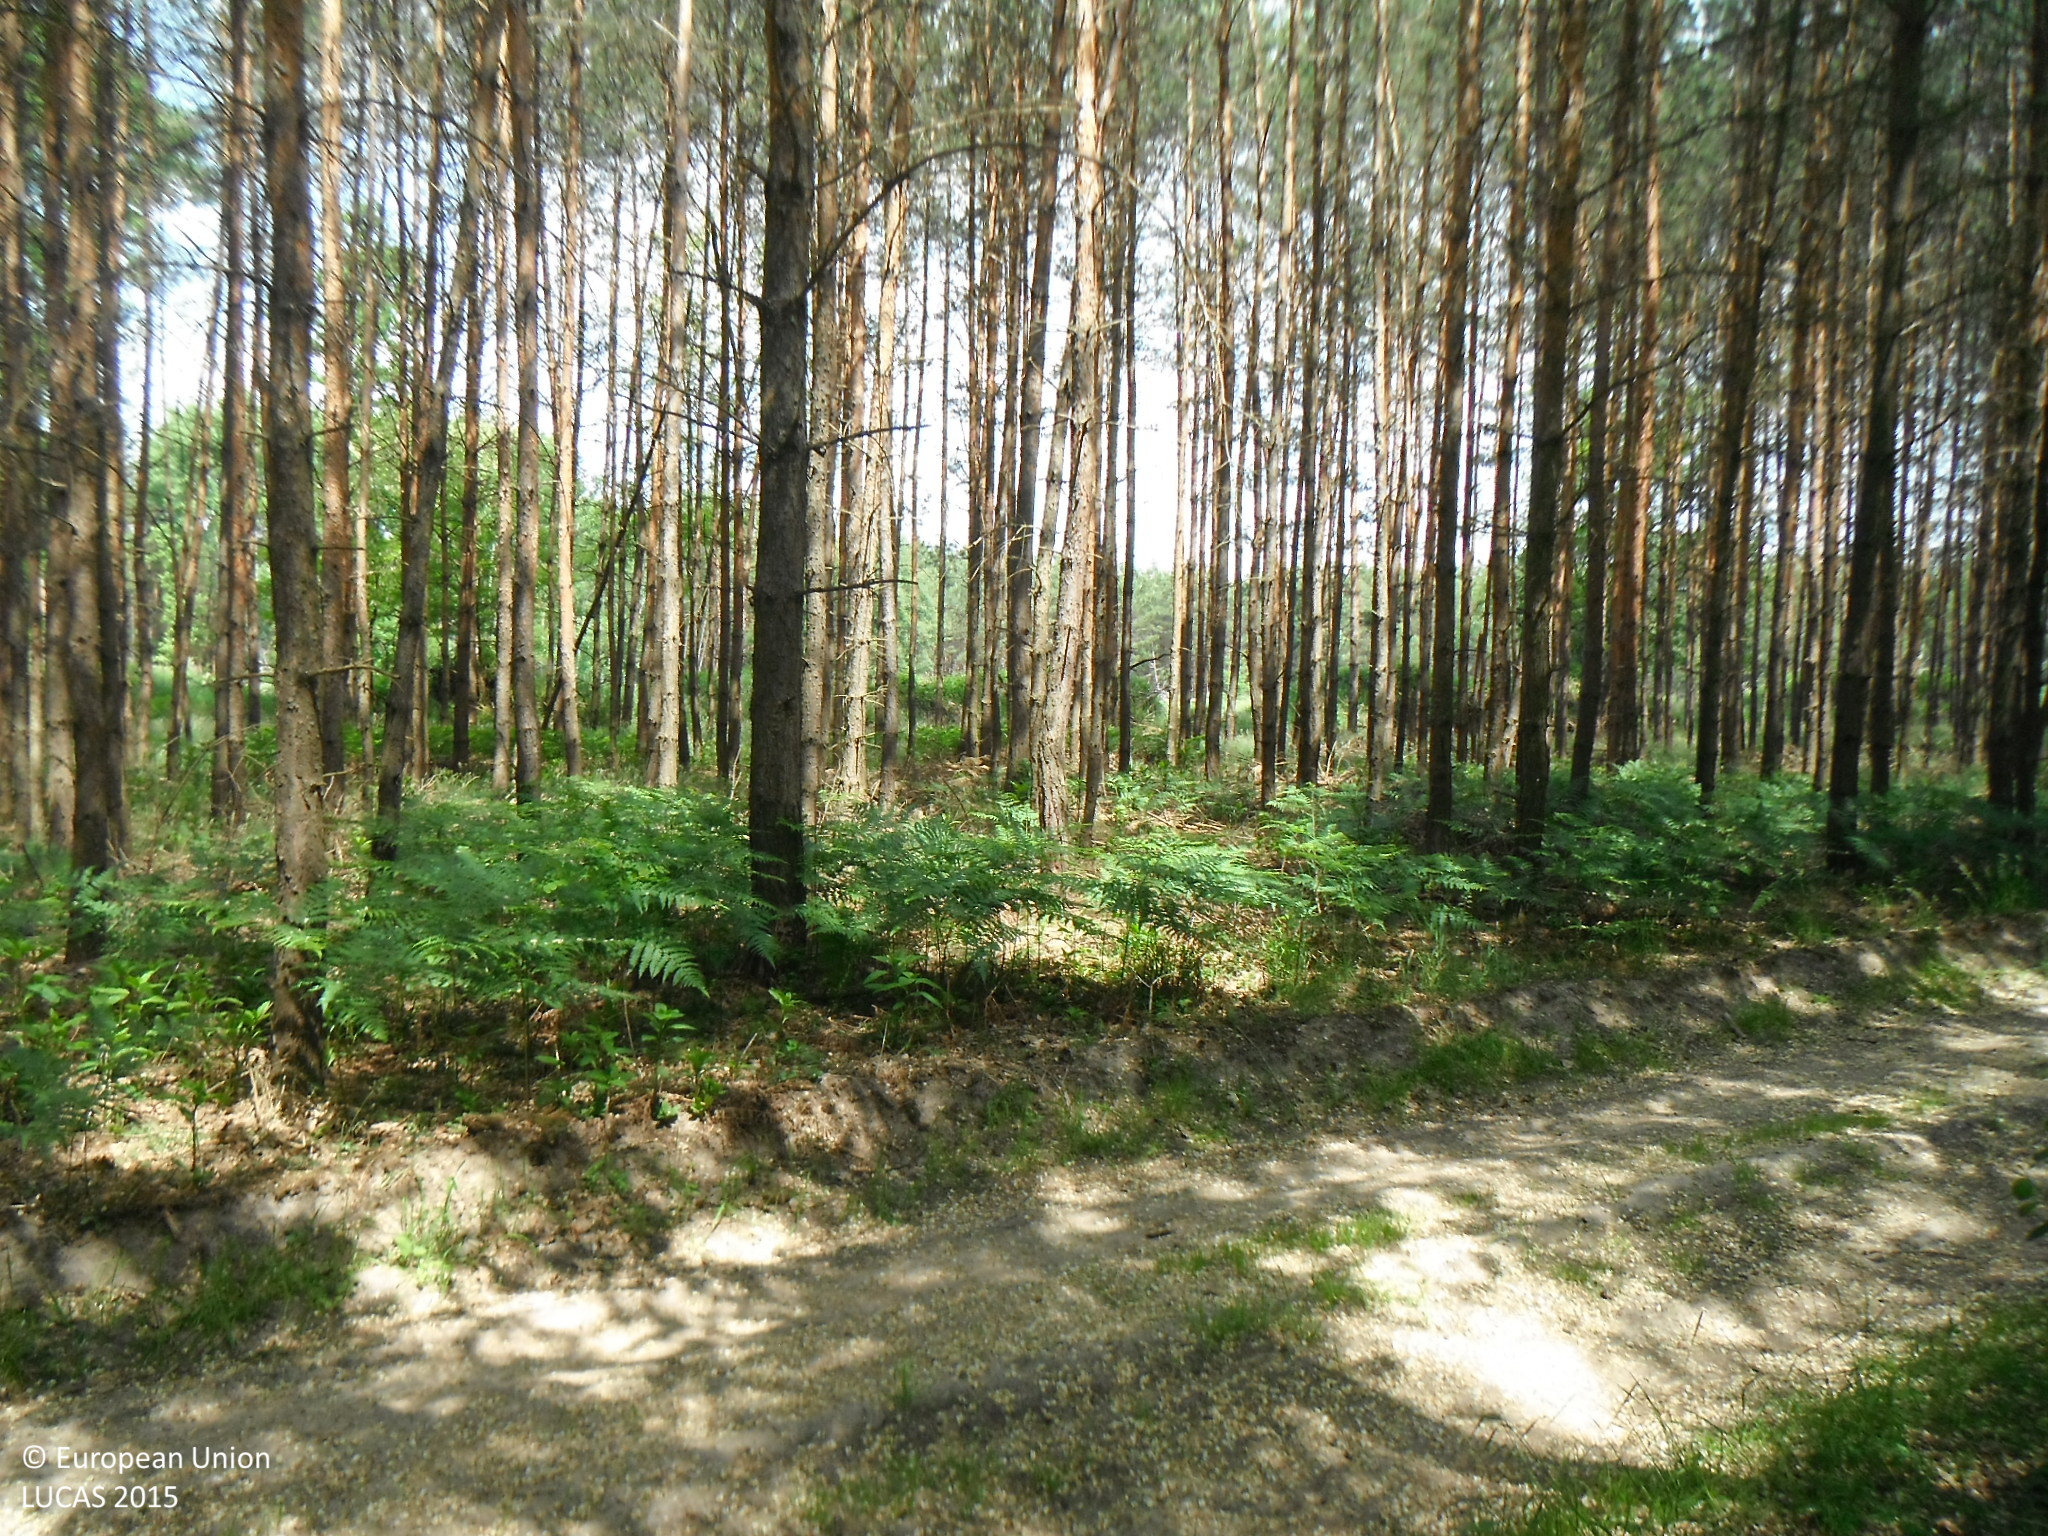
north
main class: Woodland
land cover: Broadleaved woodland
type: exotic forest
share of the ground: > 75 %
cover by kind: broadleaved forest trees 85 %, shrubs 5 %, herbaceous plants 5 %, unconsolidated bare surface 5 %
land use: Forestry
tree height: > 5 m
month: June
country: SK
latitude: 48.5513
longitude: 17.1484
